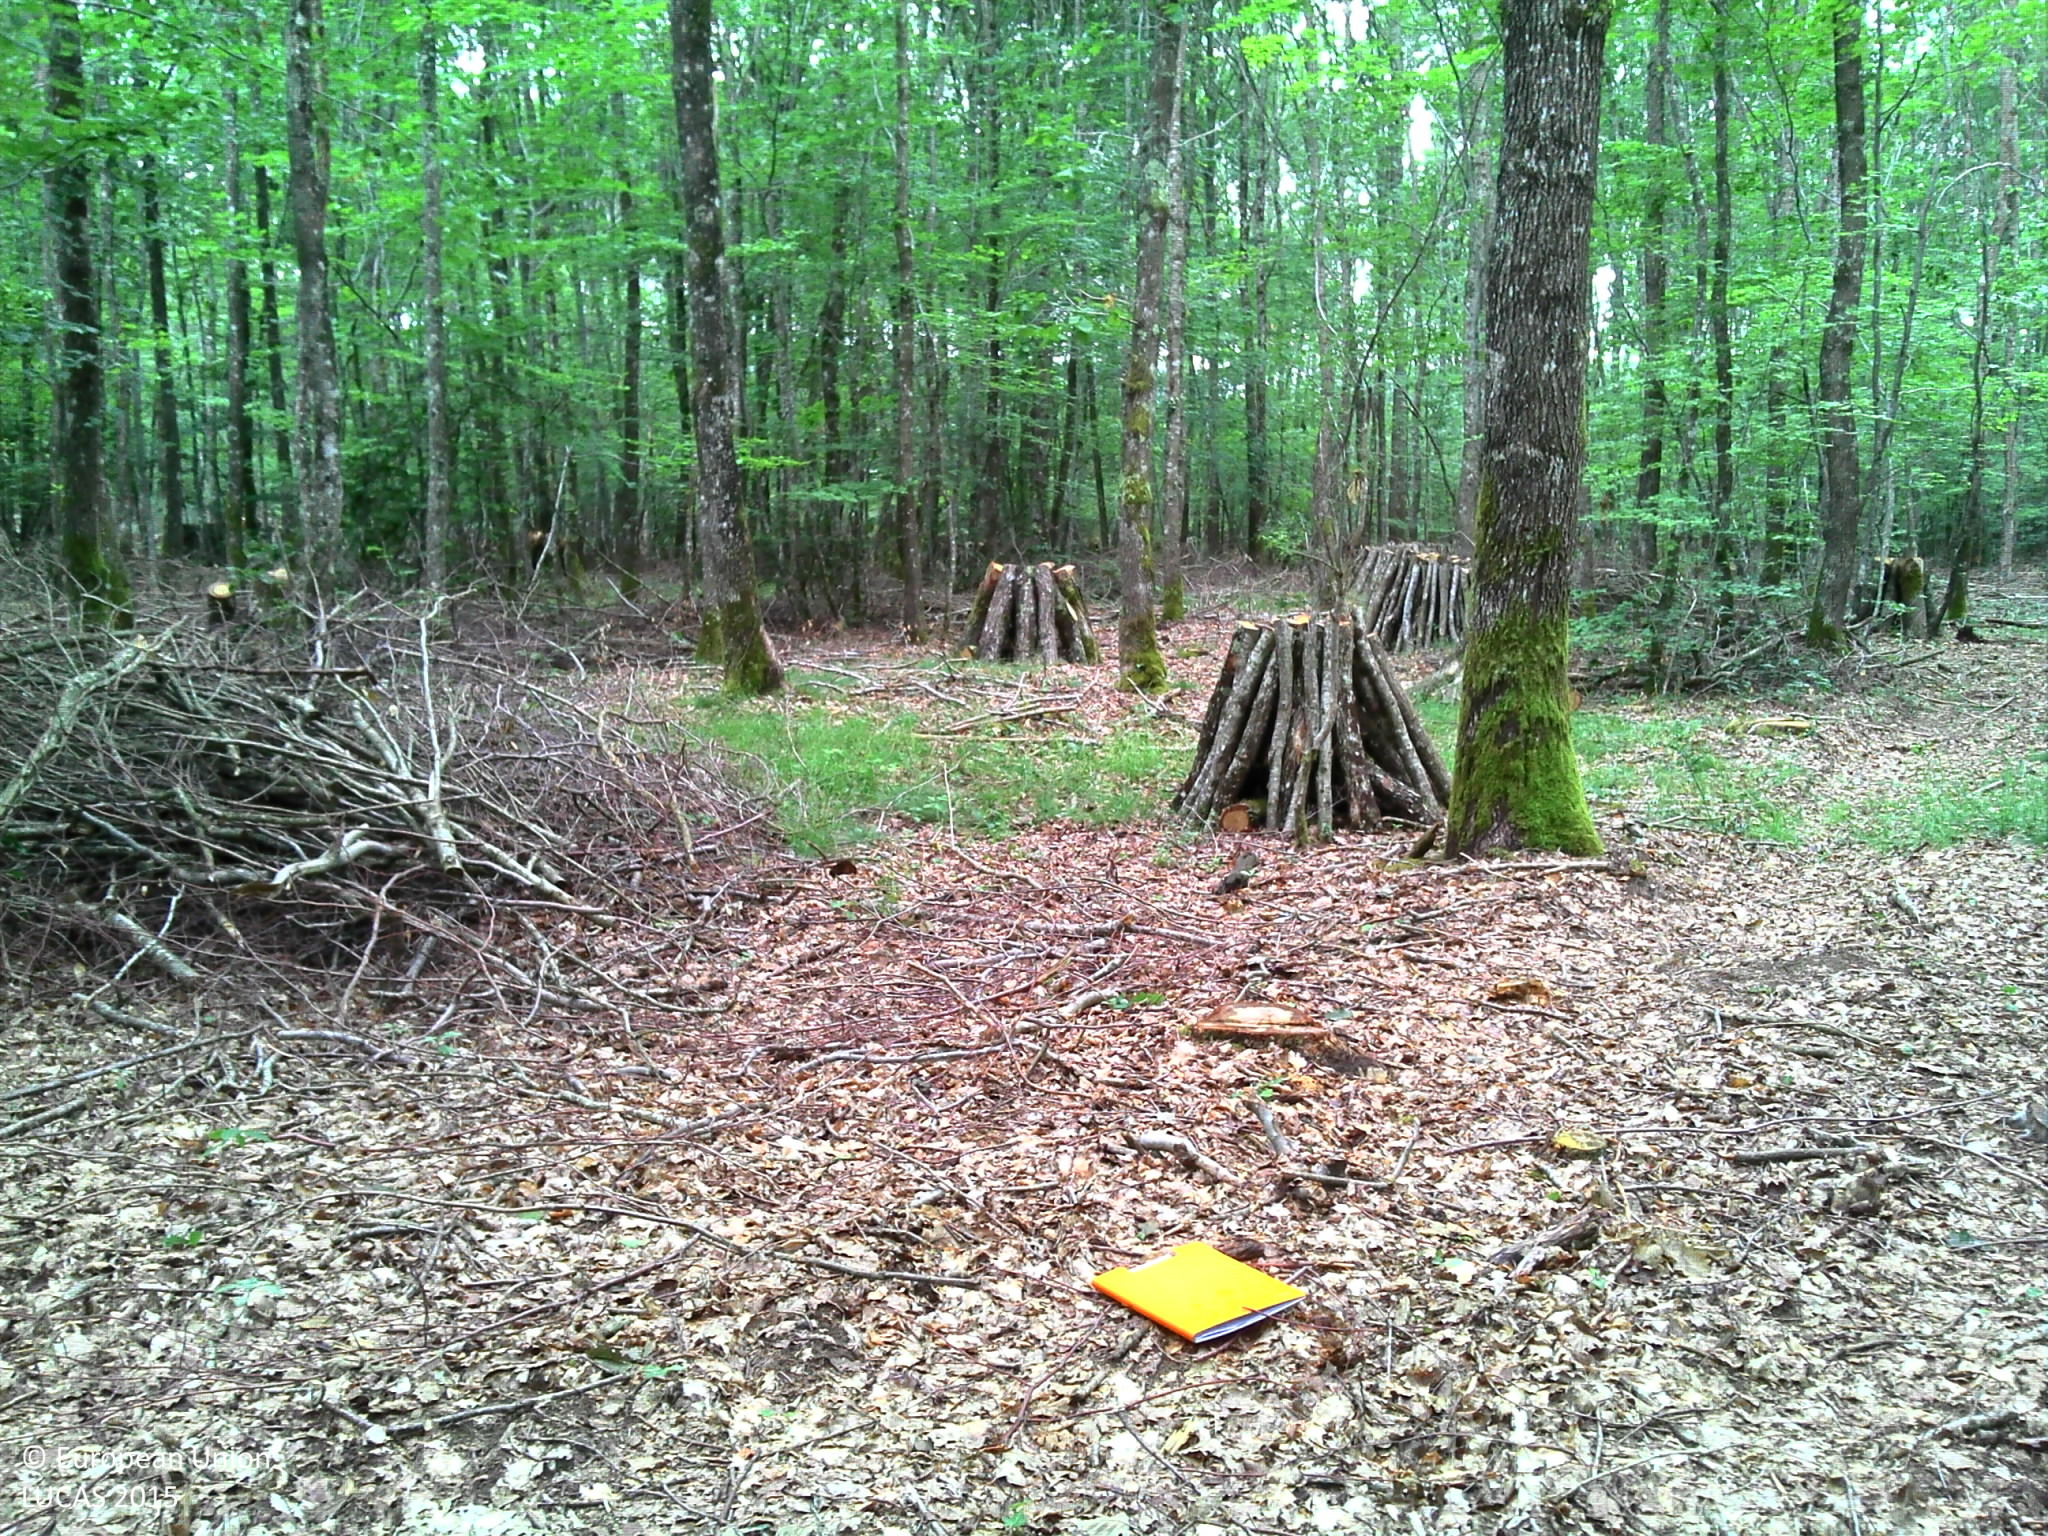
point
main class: Woodland
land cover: Broadleaved woodland
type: beech forest
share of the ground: > 75 %
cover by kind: broadleaved forest trees 90 %, herbaceous plants 5 %, unconsolidated bare surface 5 %
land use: Forestry
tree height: > 5 m
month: June
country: FR
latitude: 46.6273
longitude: 2.7208
